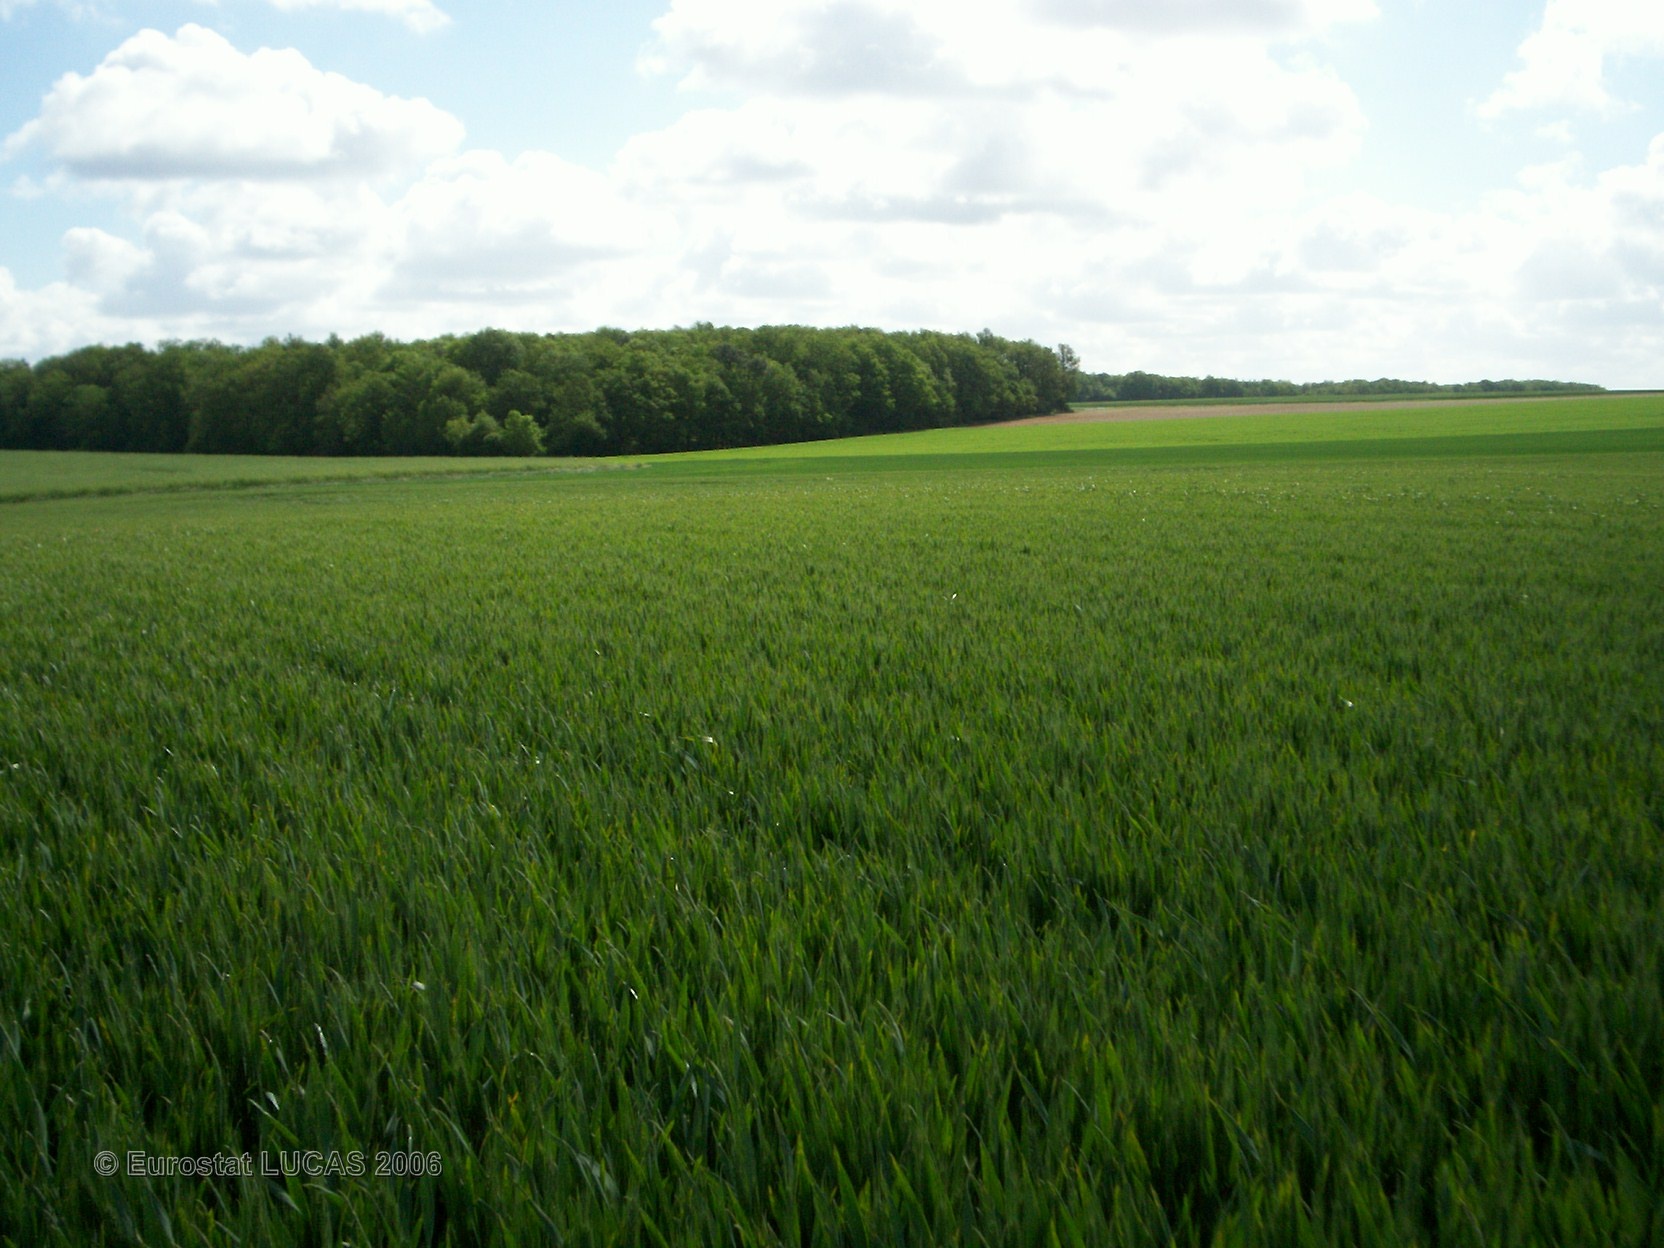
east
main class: Cropland
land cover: Common wheat
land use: Agriculture (excluding fallow land and kitchen gardens)
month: May
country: FR
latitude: 47.5884
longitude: 0.8457
